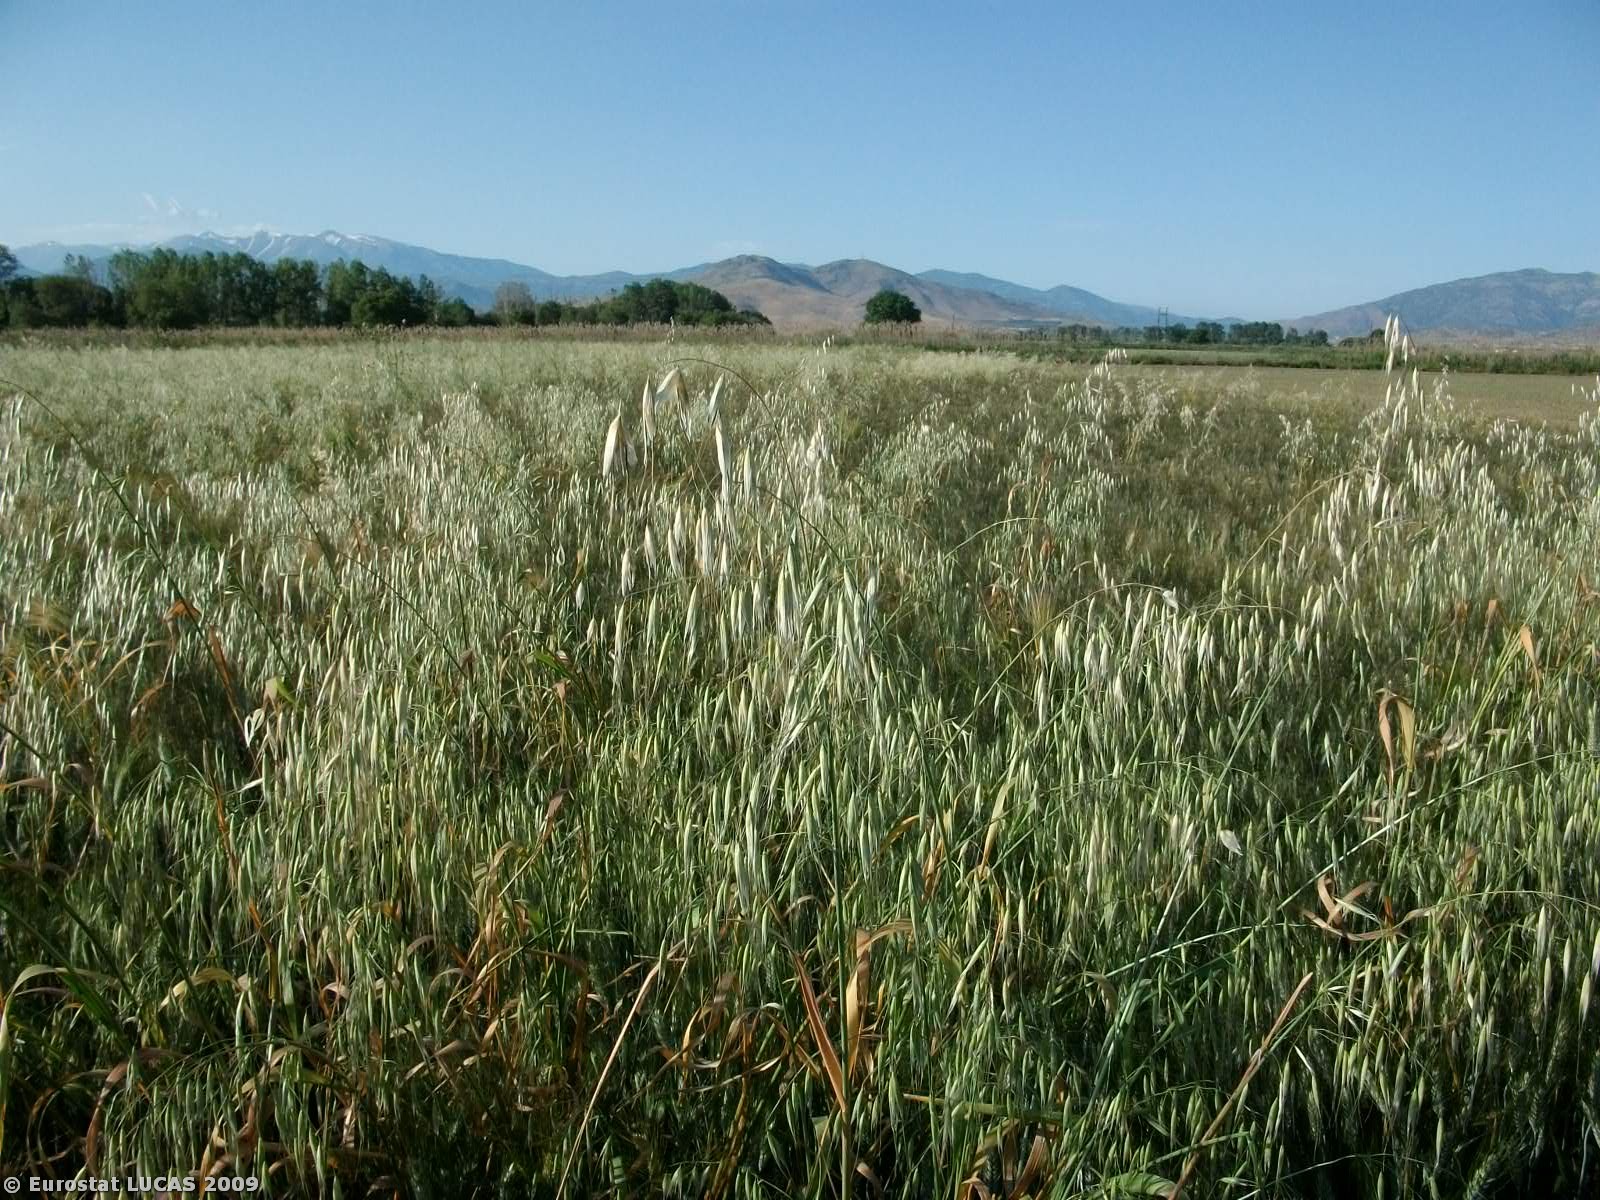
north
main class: Cropland
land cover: Durum wheat
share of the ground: > 75 %
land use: Agriculture (excluding fallow land and kitchen gardens)
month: May
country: GR
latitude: 39.7104
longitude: 22.4365
